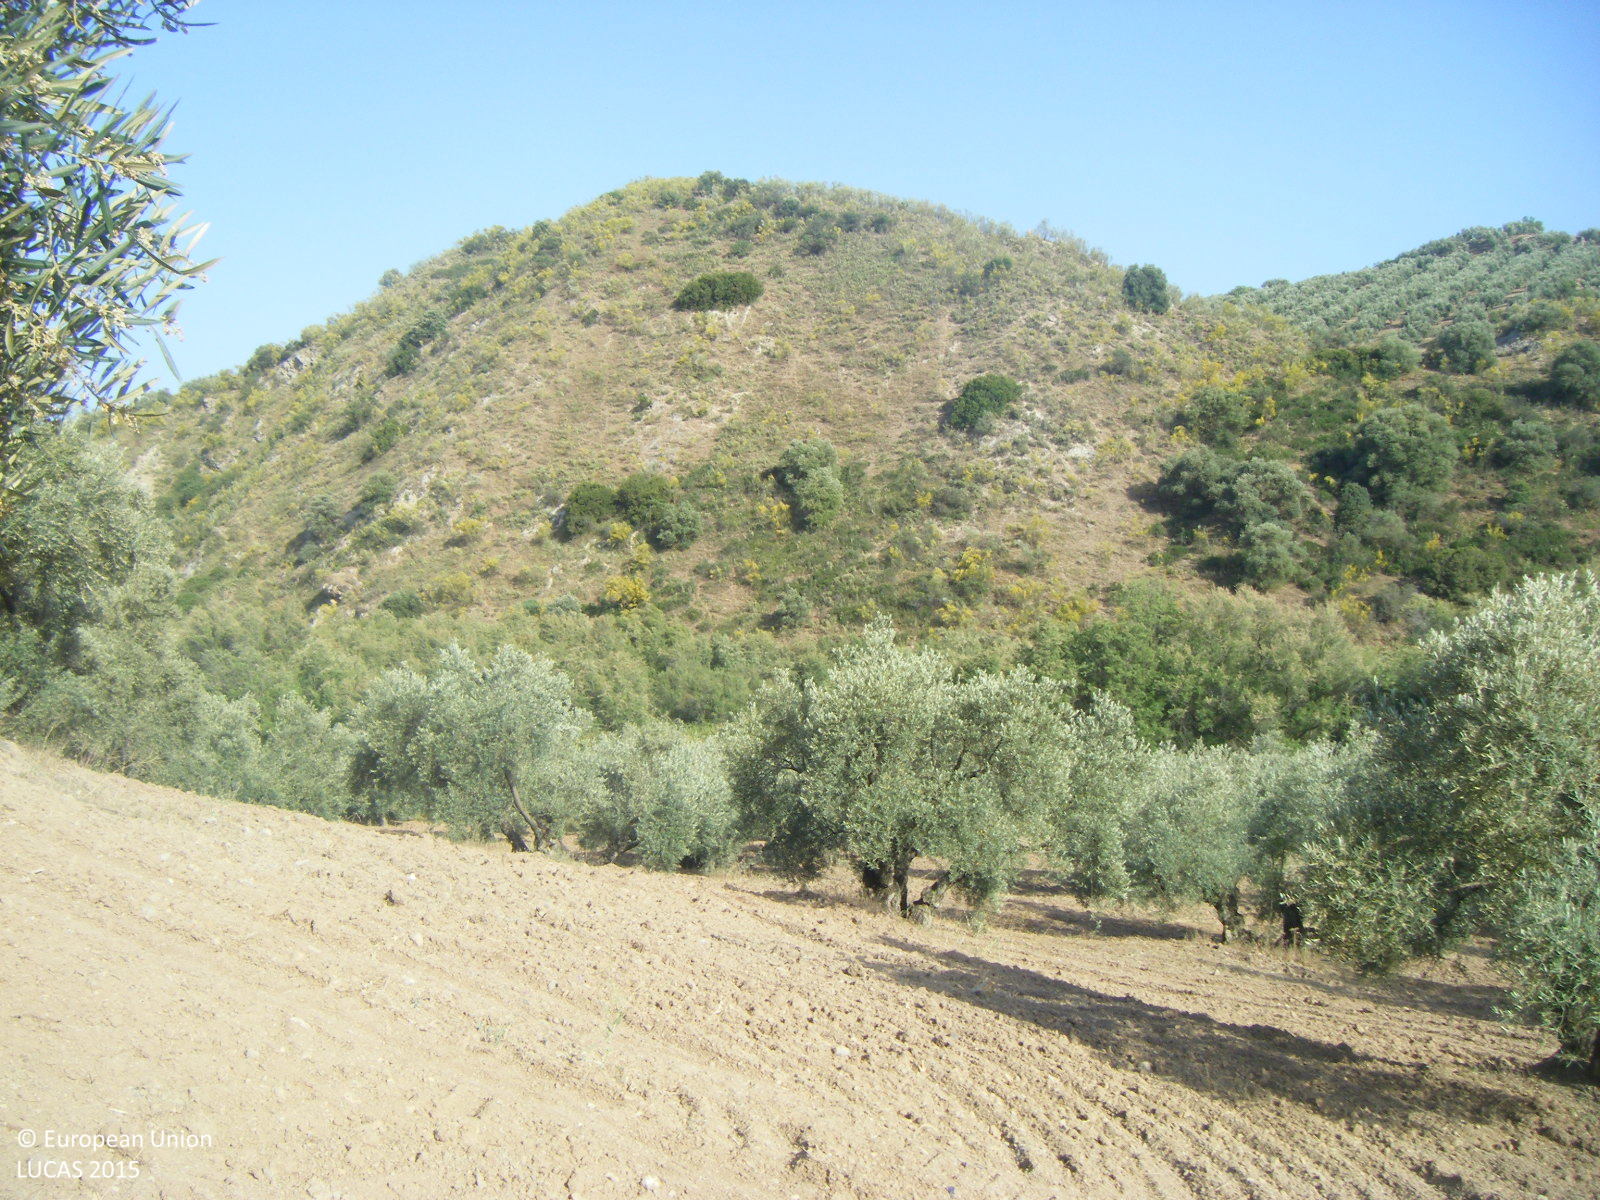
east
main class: Cropland
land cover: Olive groves
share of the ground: 10 - 25 %
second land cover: Shrubland without tree cover
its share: 10 - 25 %
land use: Agriculture (excluding fallow land and kitchen gardens)
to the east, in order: Olive groves; Shrubland without tree cover; Broadleaved woodland; Rivers and streams; Broadleaved woodland
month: May
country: ES
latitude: 37.3390
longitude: -4.5516
